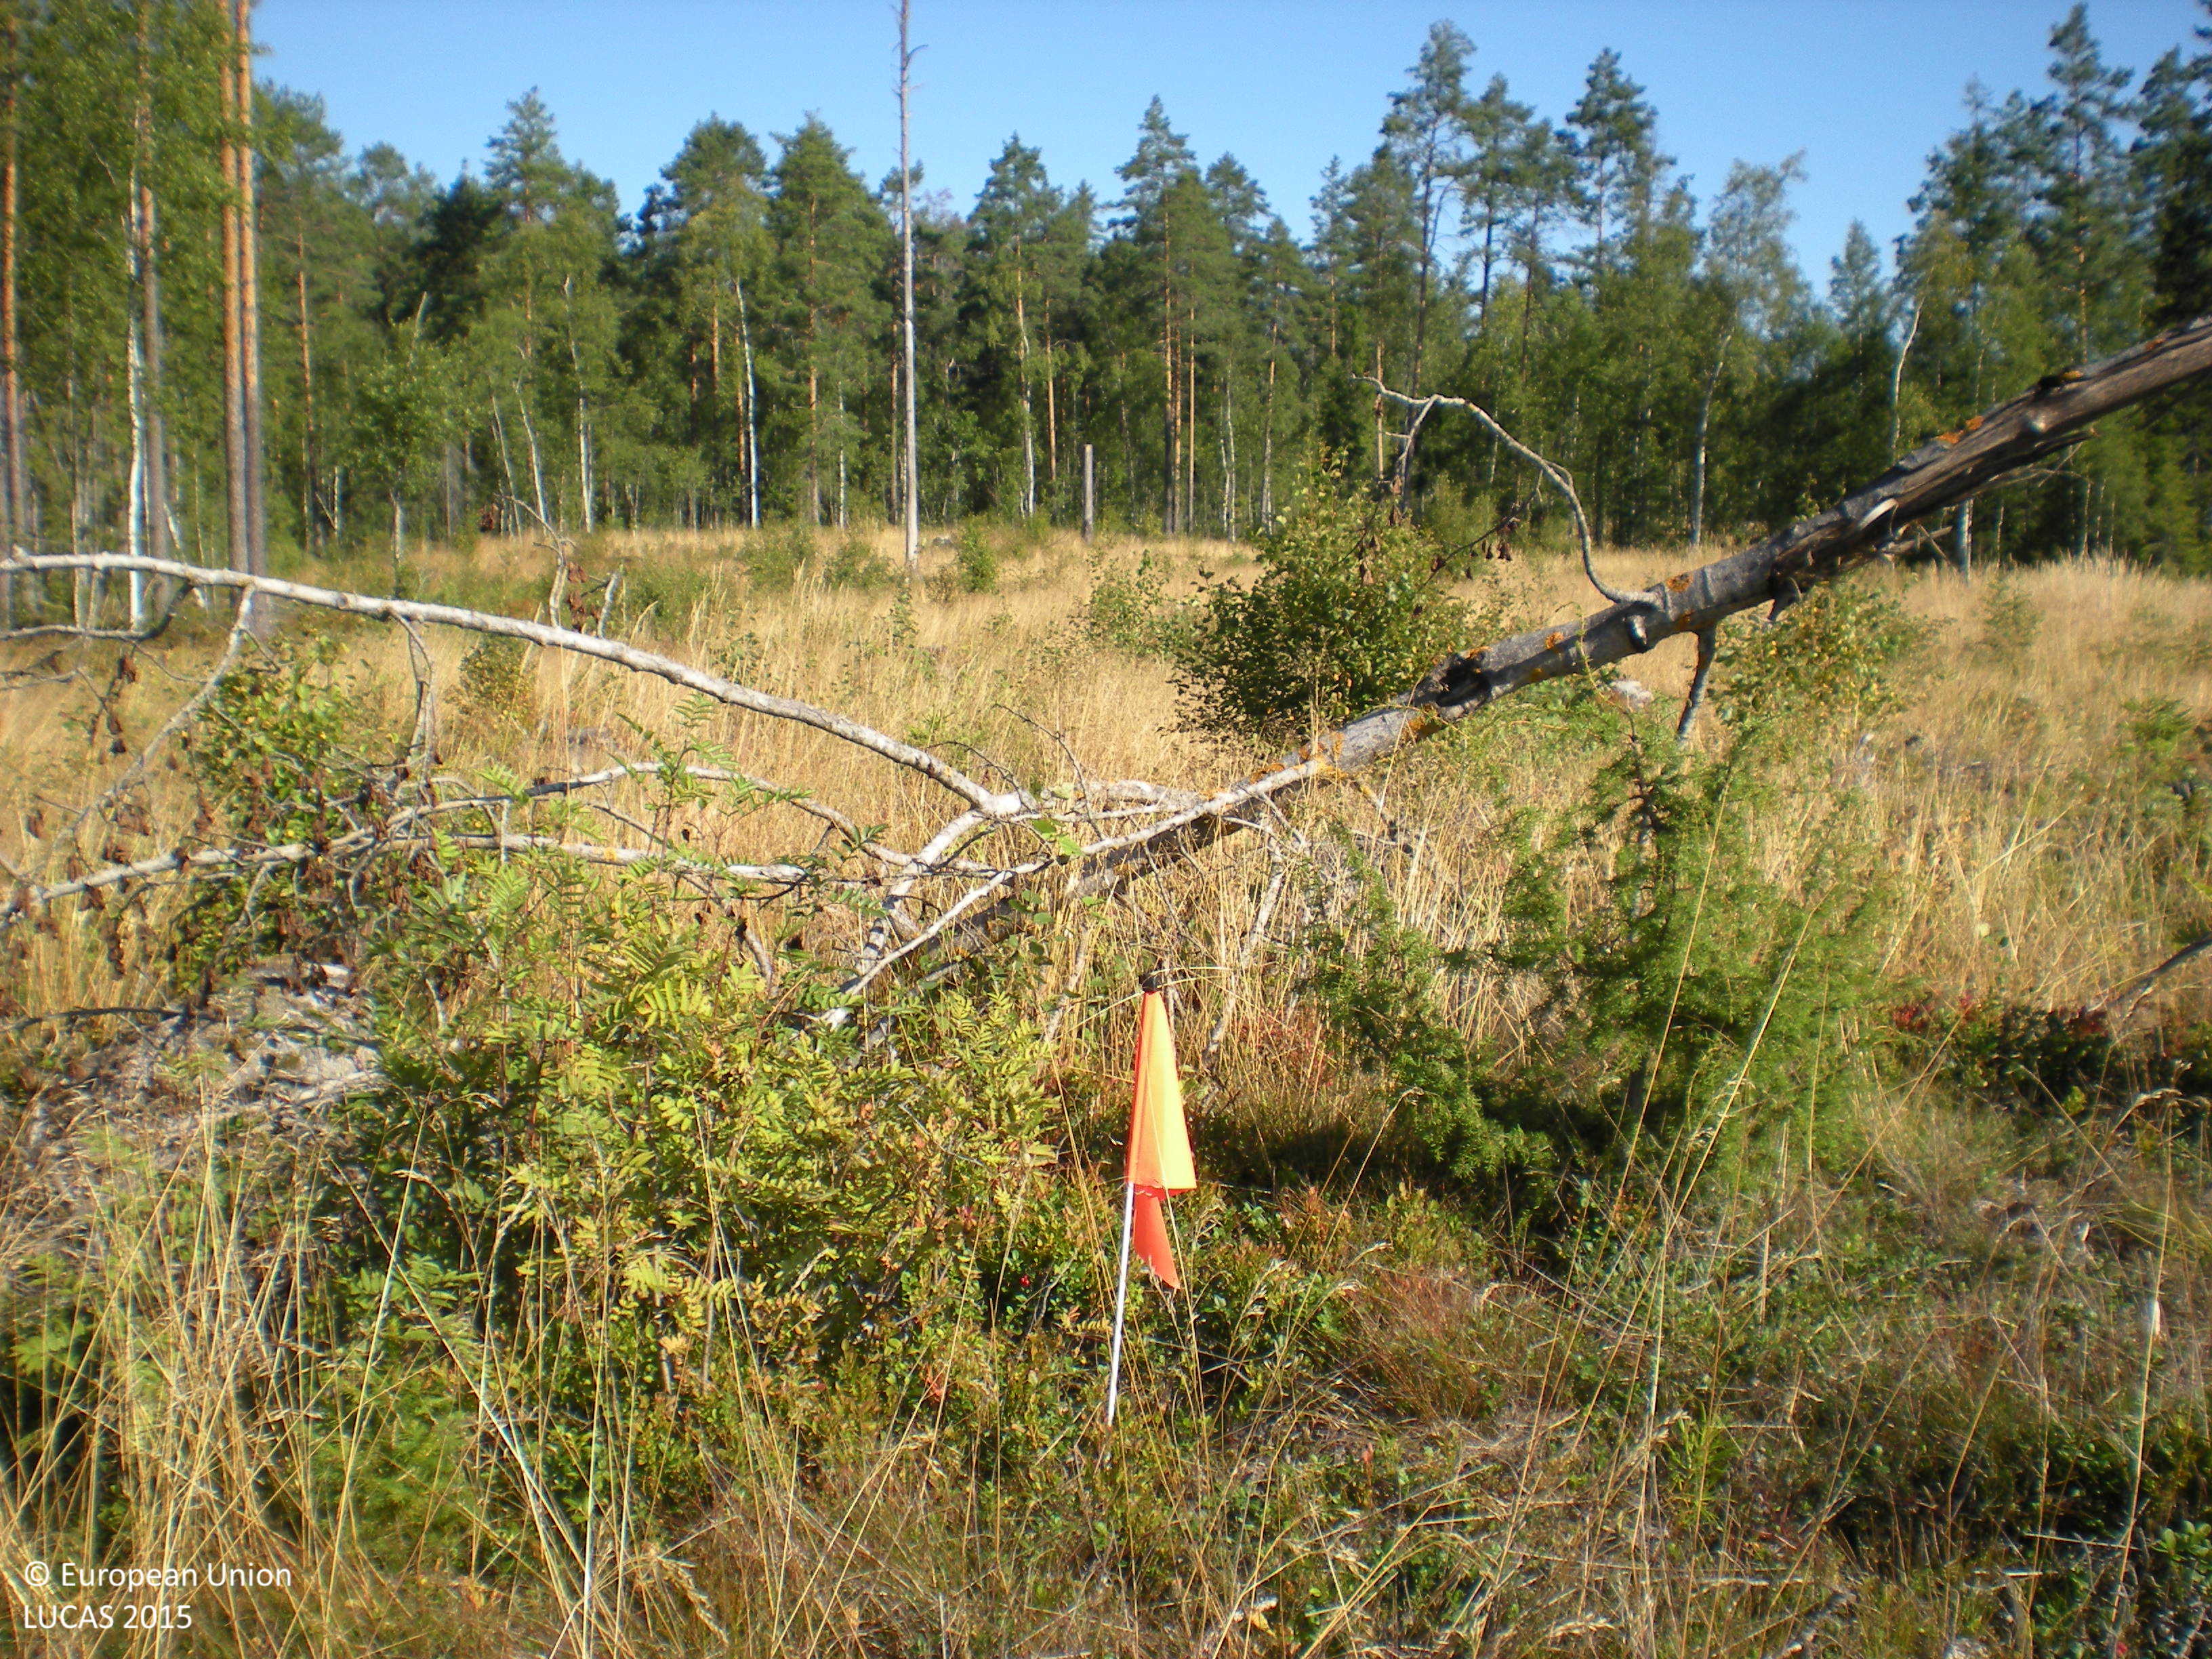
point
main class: Woodland
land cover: Broadleaved woodland
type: boreal forest
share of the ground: 10 - 25 %
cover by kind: herbaceous plants 50 %, broadleaved forest trees 25 %, shrubs 20 %, coniferous forest trees 5 %
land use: Forestry
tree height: < 5 m
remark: Clear cut
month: August
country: SE
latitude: 60.6096
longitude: 17.2417
